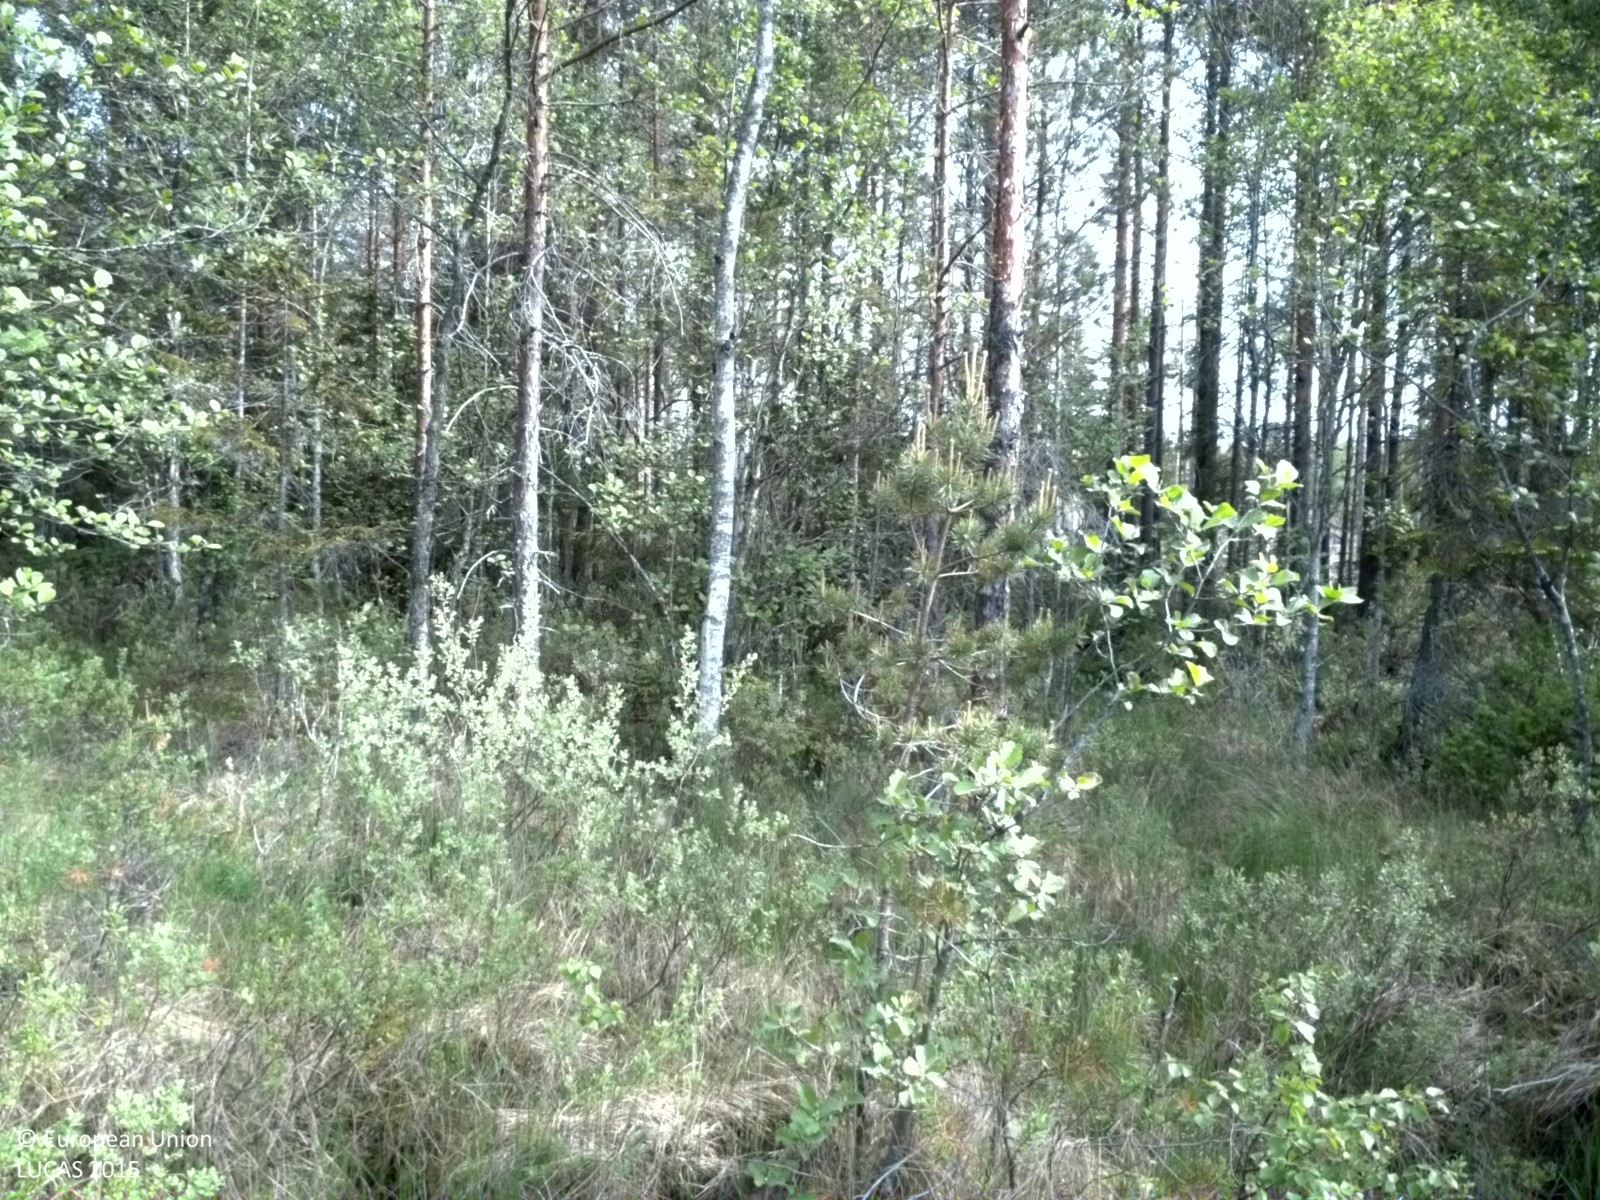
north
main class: Woodland
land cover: Pine dominated coniferous woodland
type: mire and swamp forests
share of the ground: 25 - 50 %
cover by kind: coniferous forest trees 40 %, shrubs 25 %, herbaceous plants 15 %, lichens and mosses 15 %, broadleaved forest trees 5 %
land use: Semi-natural and natural areas not in use
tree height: > 5 m
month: June
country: SE
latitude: 60.2481
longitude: 17.2355
